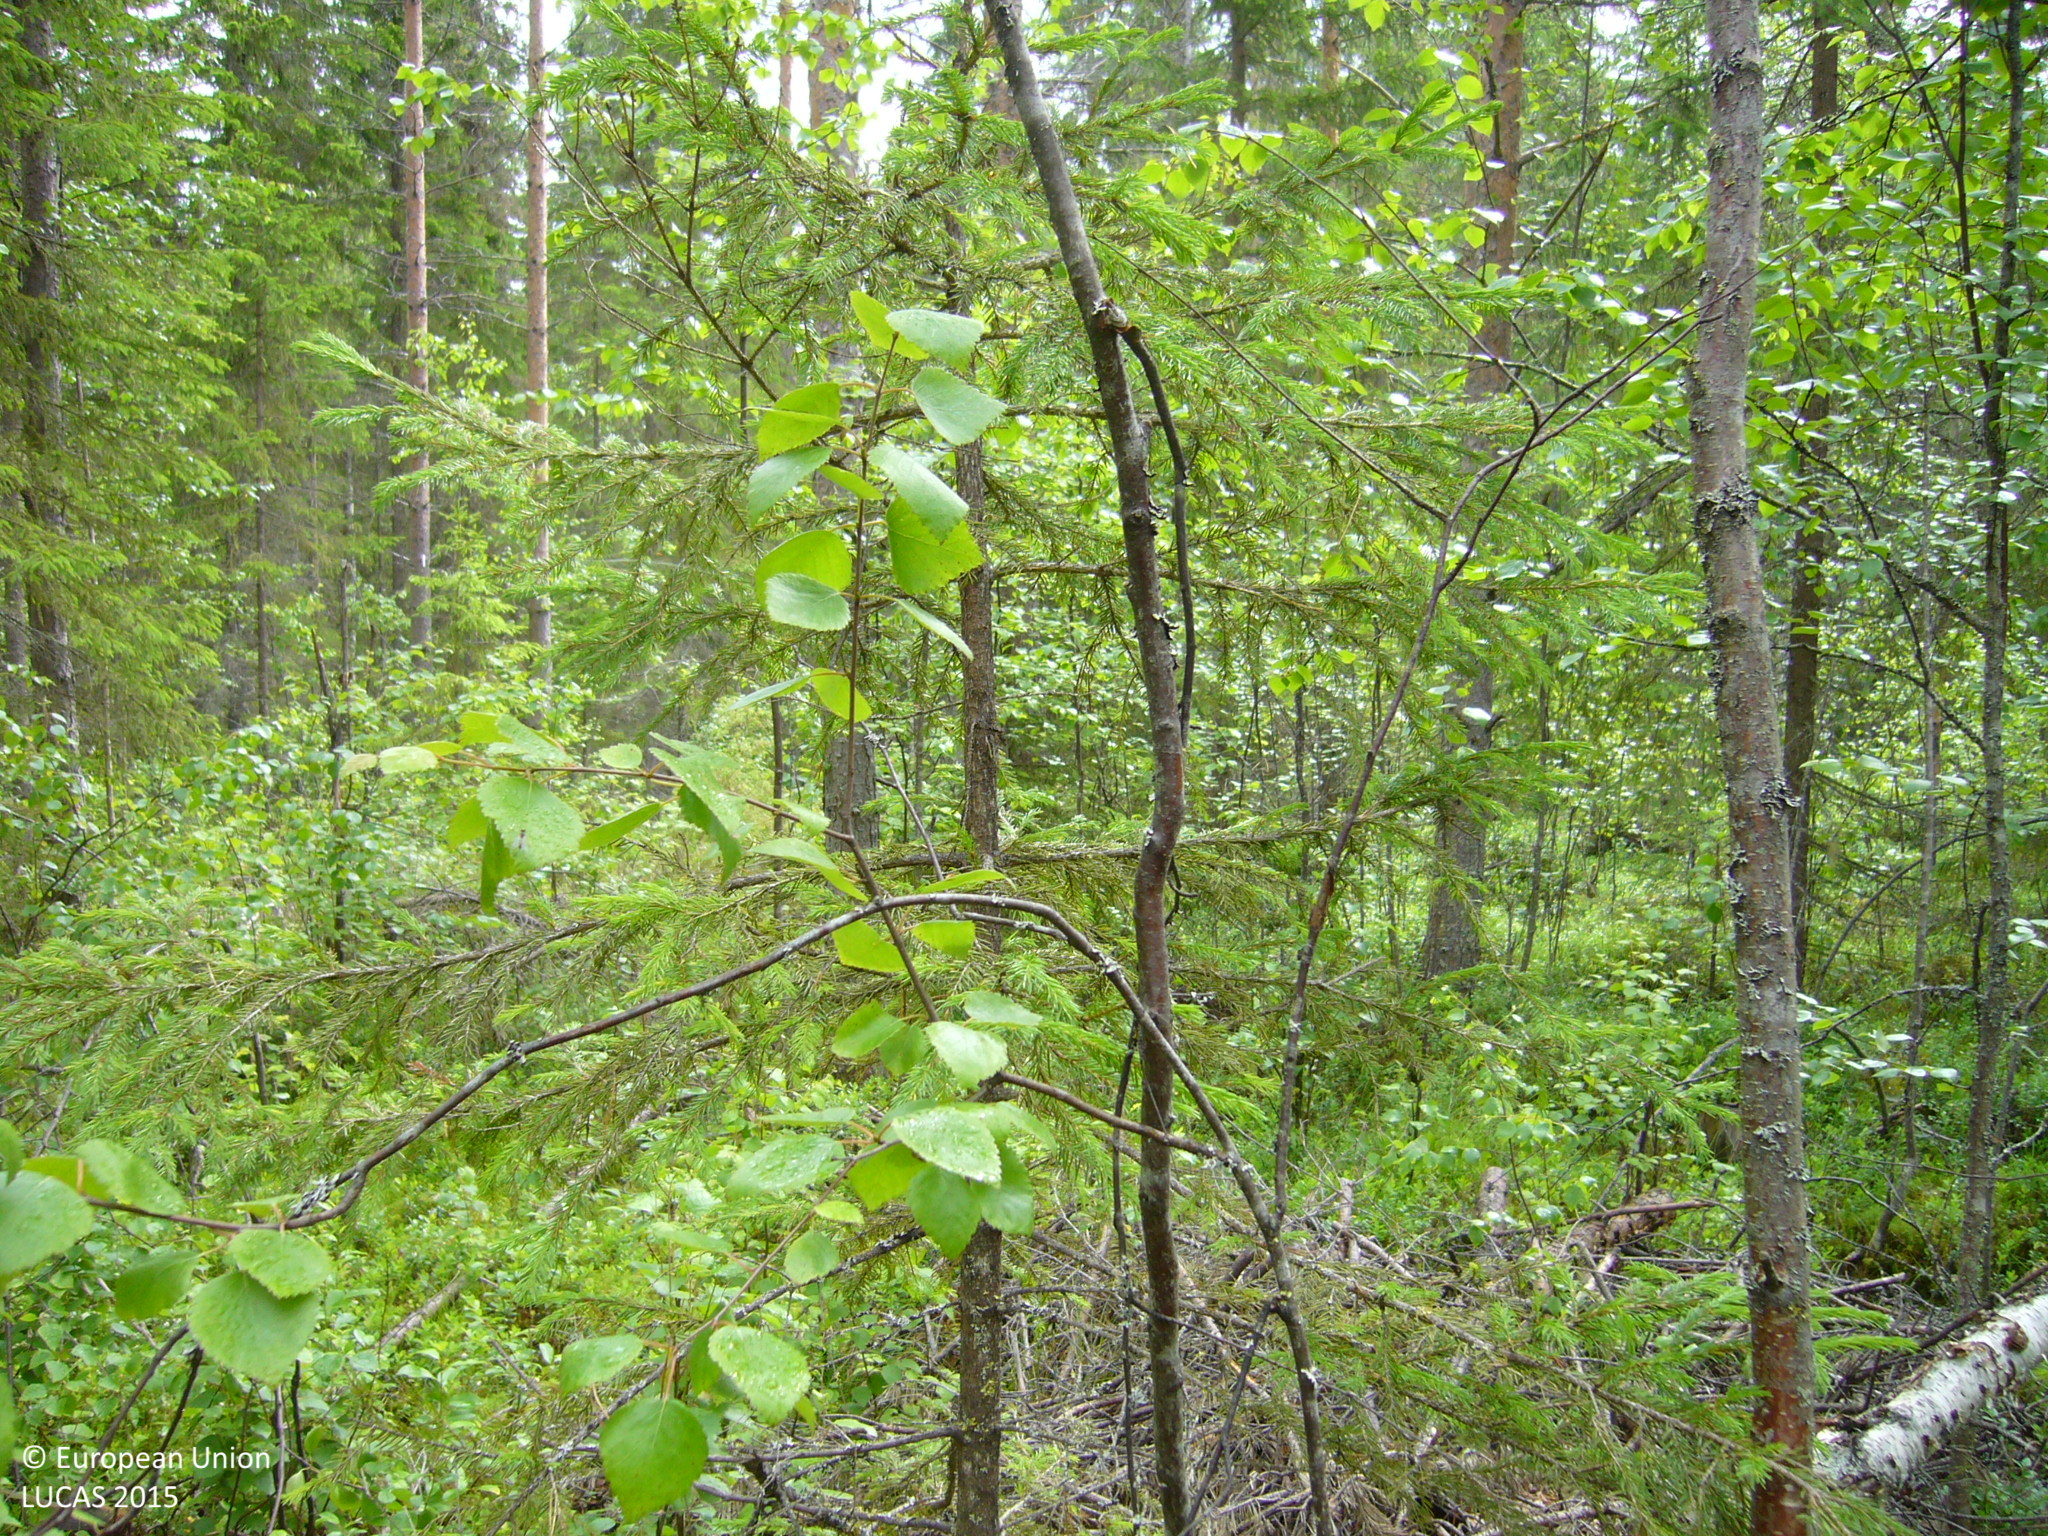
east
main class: Woodland
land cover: Pine dominated mixed woodland
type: boreal forest
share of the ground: > 75 %
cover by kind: coniferous forest trees 50 %, broadleaved forest trees 25 %, shrubs 25 %
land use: Forestry
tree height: > 5 m
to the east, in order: Pine dominated mixed woodland; Spruce dominated coniferous woodland; Tracks; Spruce dominated mixed woodland; Tracks; Spruce dominated mixed woodland; Inland fresh running water; Spruce dominated mixed woodland
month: July
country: FI
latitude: 63.3419
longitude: 25.4241
